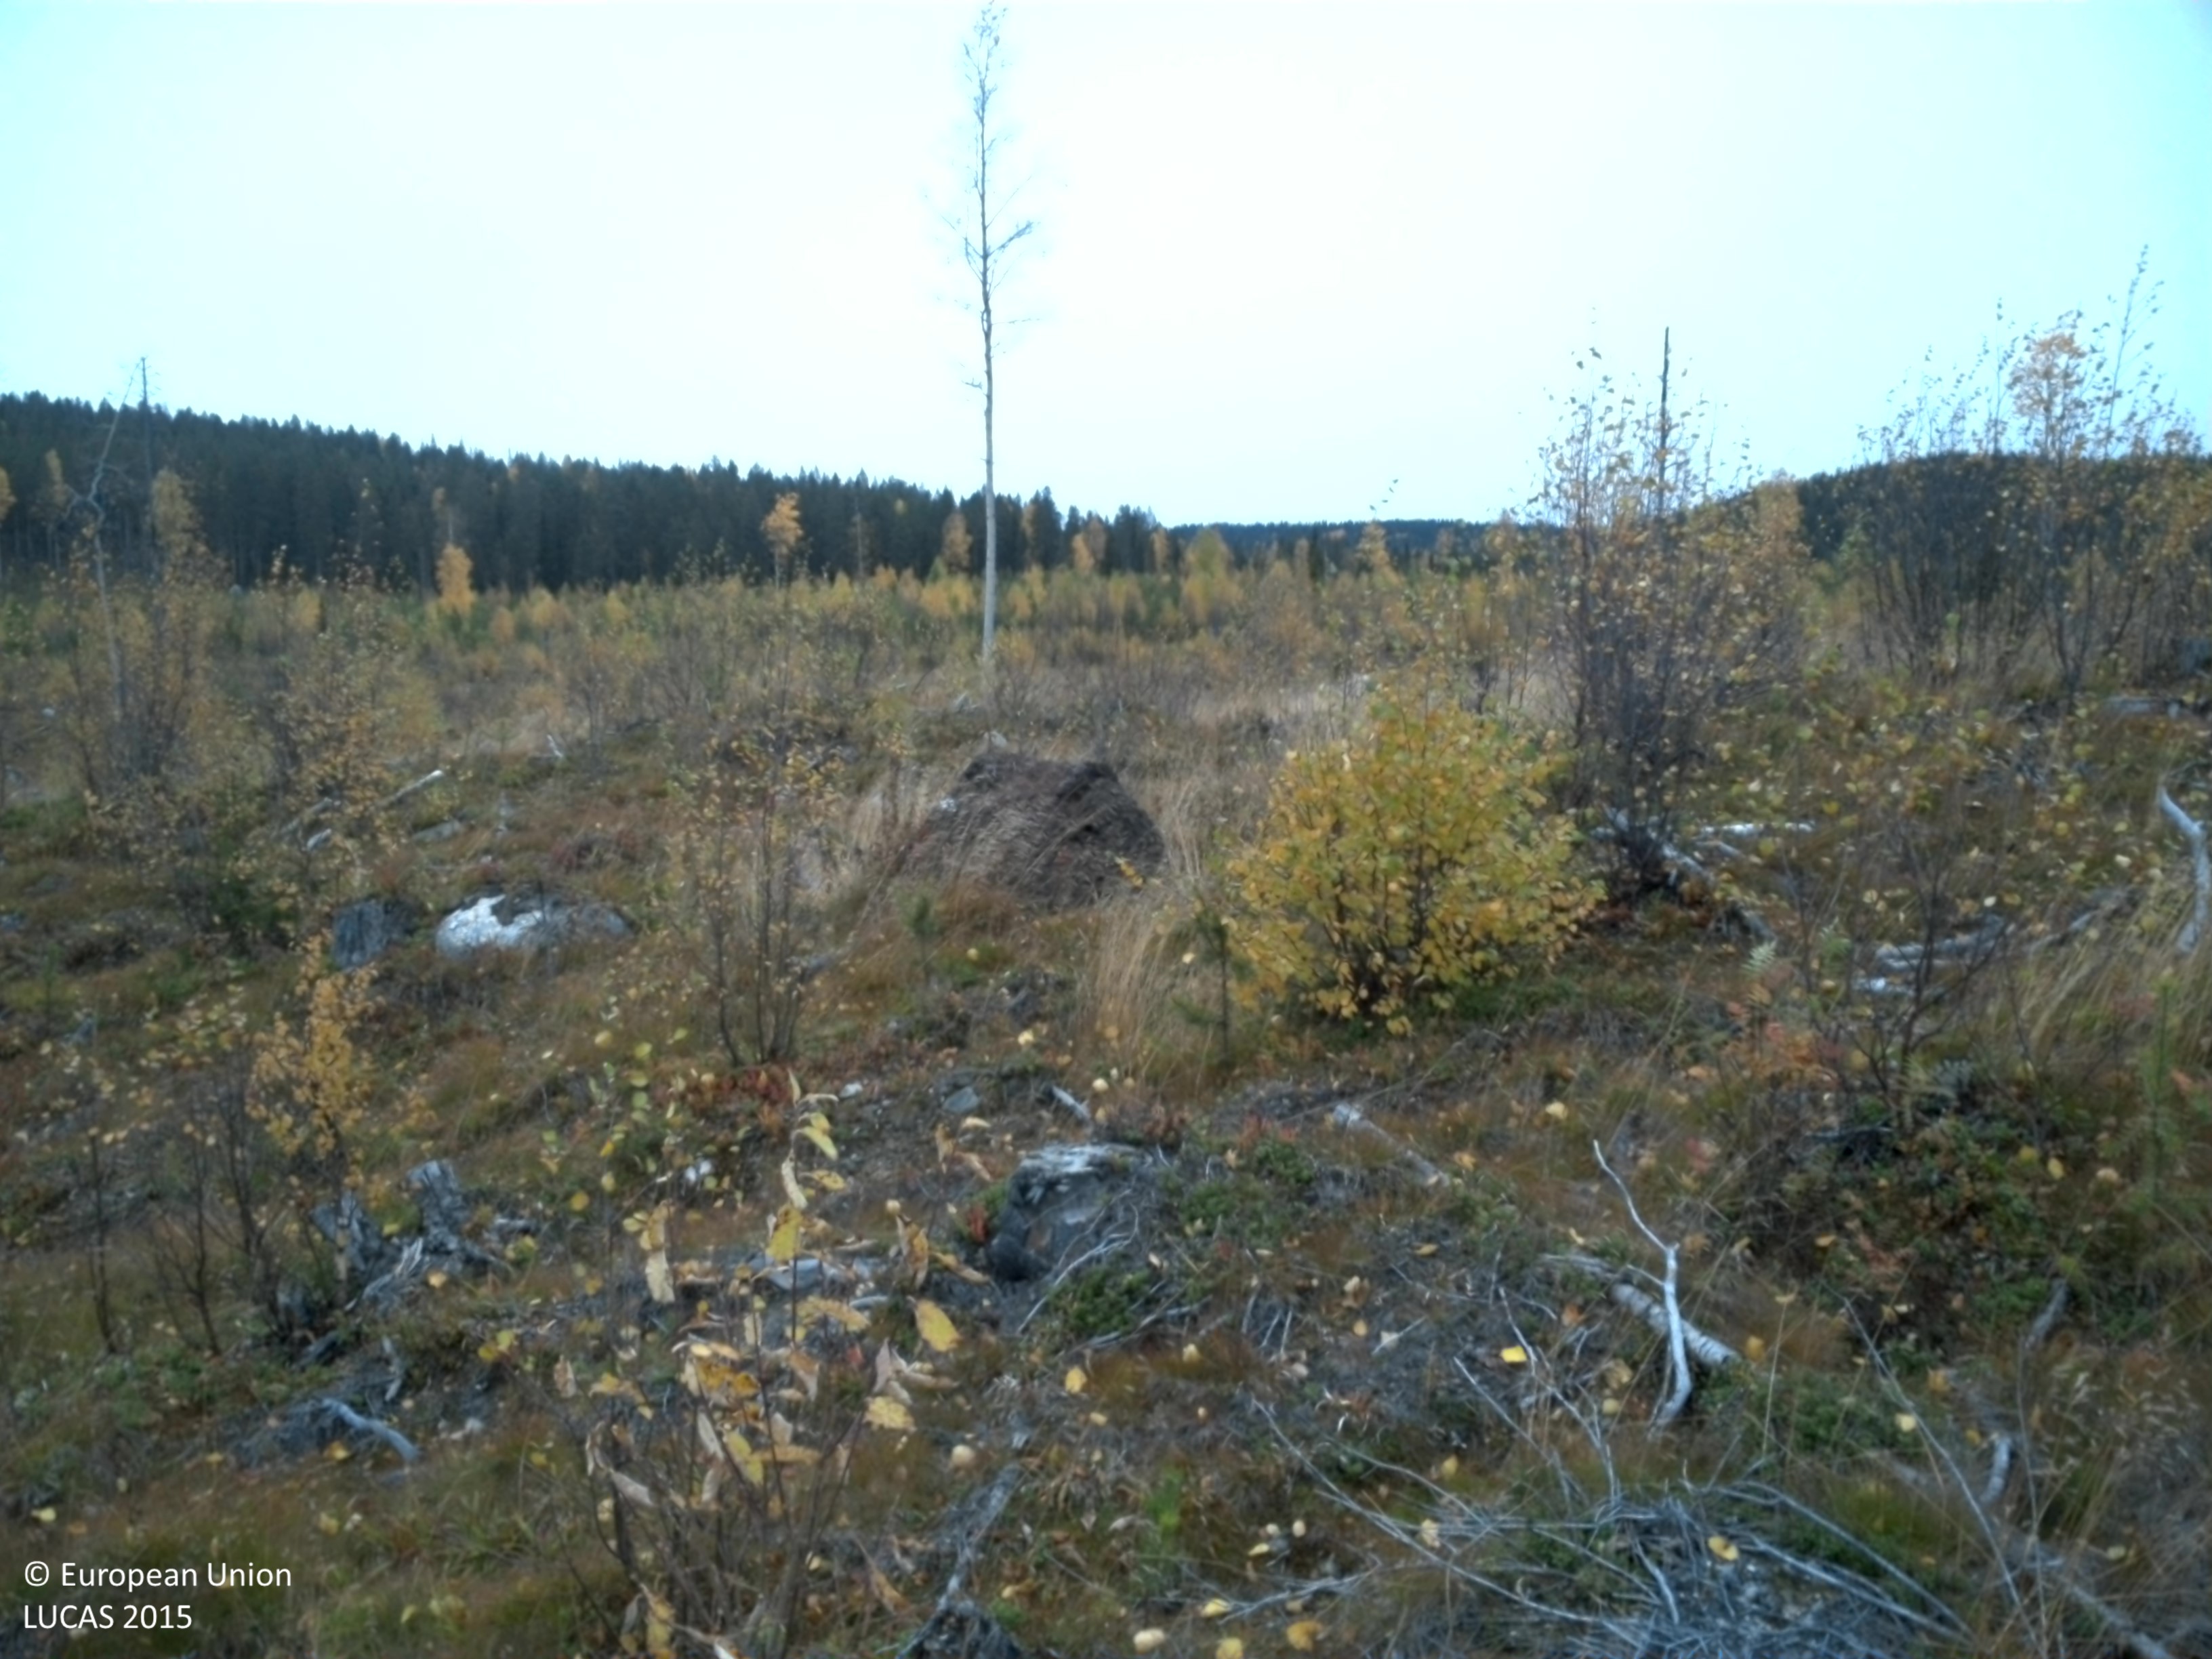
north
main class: Woodland
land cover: Broadleaved woodland
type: non-riverine alder, birch or aspen forest
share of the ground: 10 - 25 %
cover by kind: herbaceous plants 65 %, lichens and mosses 15 %, broadleaved forest trees 10 %, shrubs 5 %, unconsolidated bare surface 5 %
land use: Forestry
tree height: < 5 m
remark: Clear cut
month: October
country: SE
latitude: 64.9480
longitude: 17.4777
